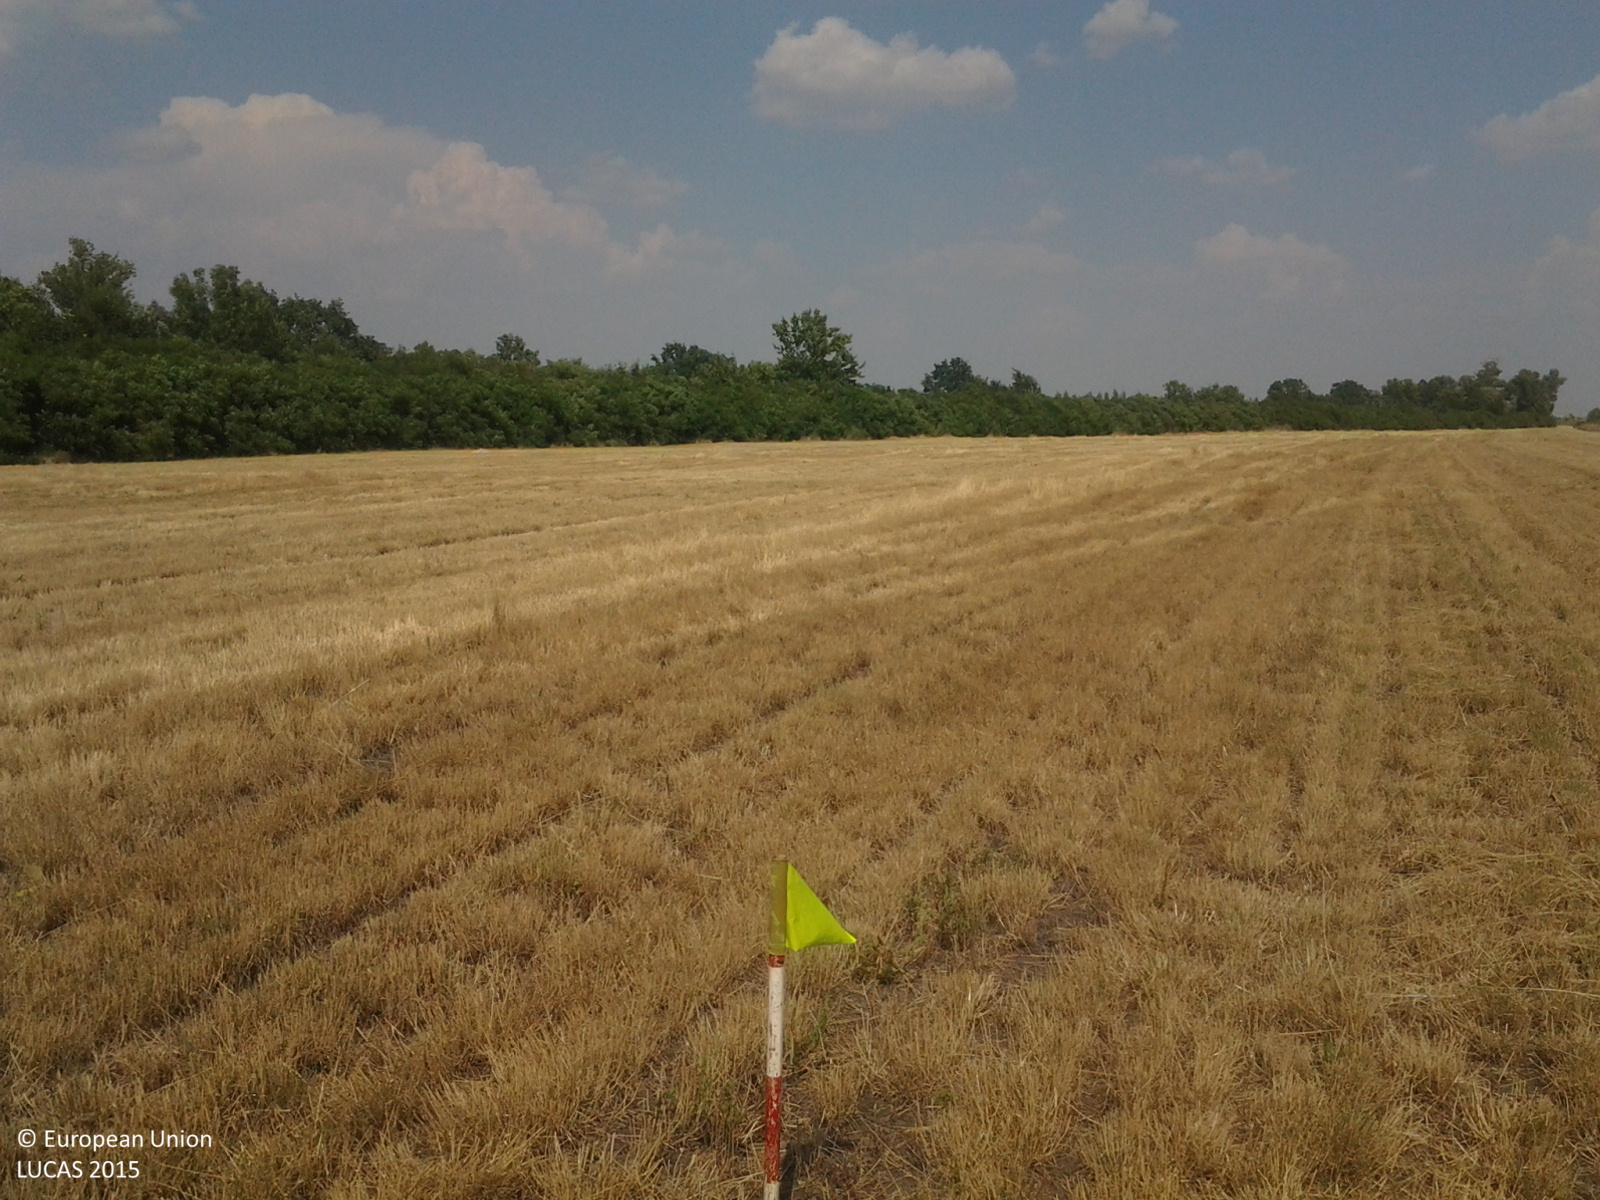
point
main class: Cropland
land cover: Common wheat
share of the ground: < 10 %
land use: Agriculture (excluding fallow land and kitchen gardens)
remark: Harvested field
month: July
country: HU
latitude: 47.2454
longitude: 20.7205
